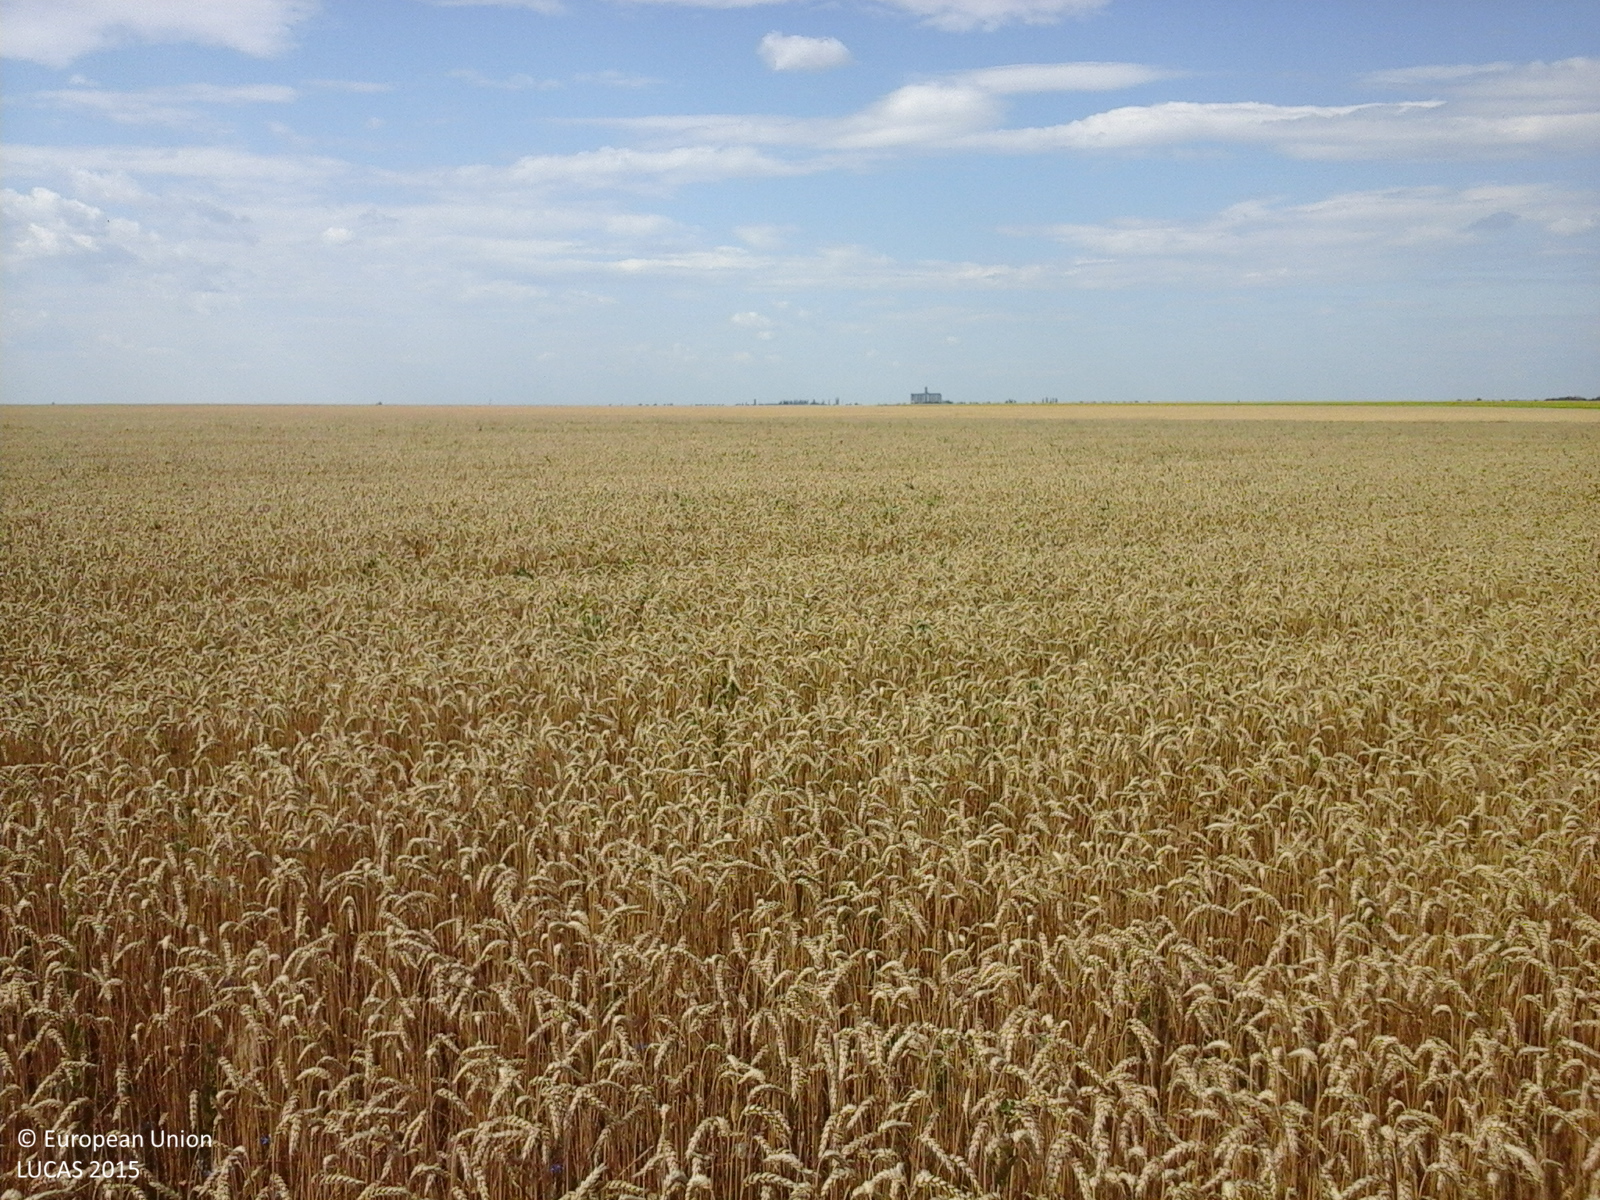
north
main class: Cropland
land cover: Common wheat
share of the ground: > 75 %
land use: Agriculture (excluding fallow land and kitchen gardens)
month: July
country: RO
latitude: 44.0708
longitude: 24.6661
